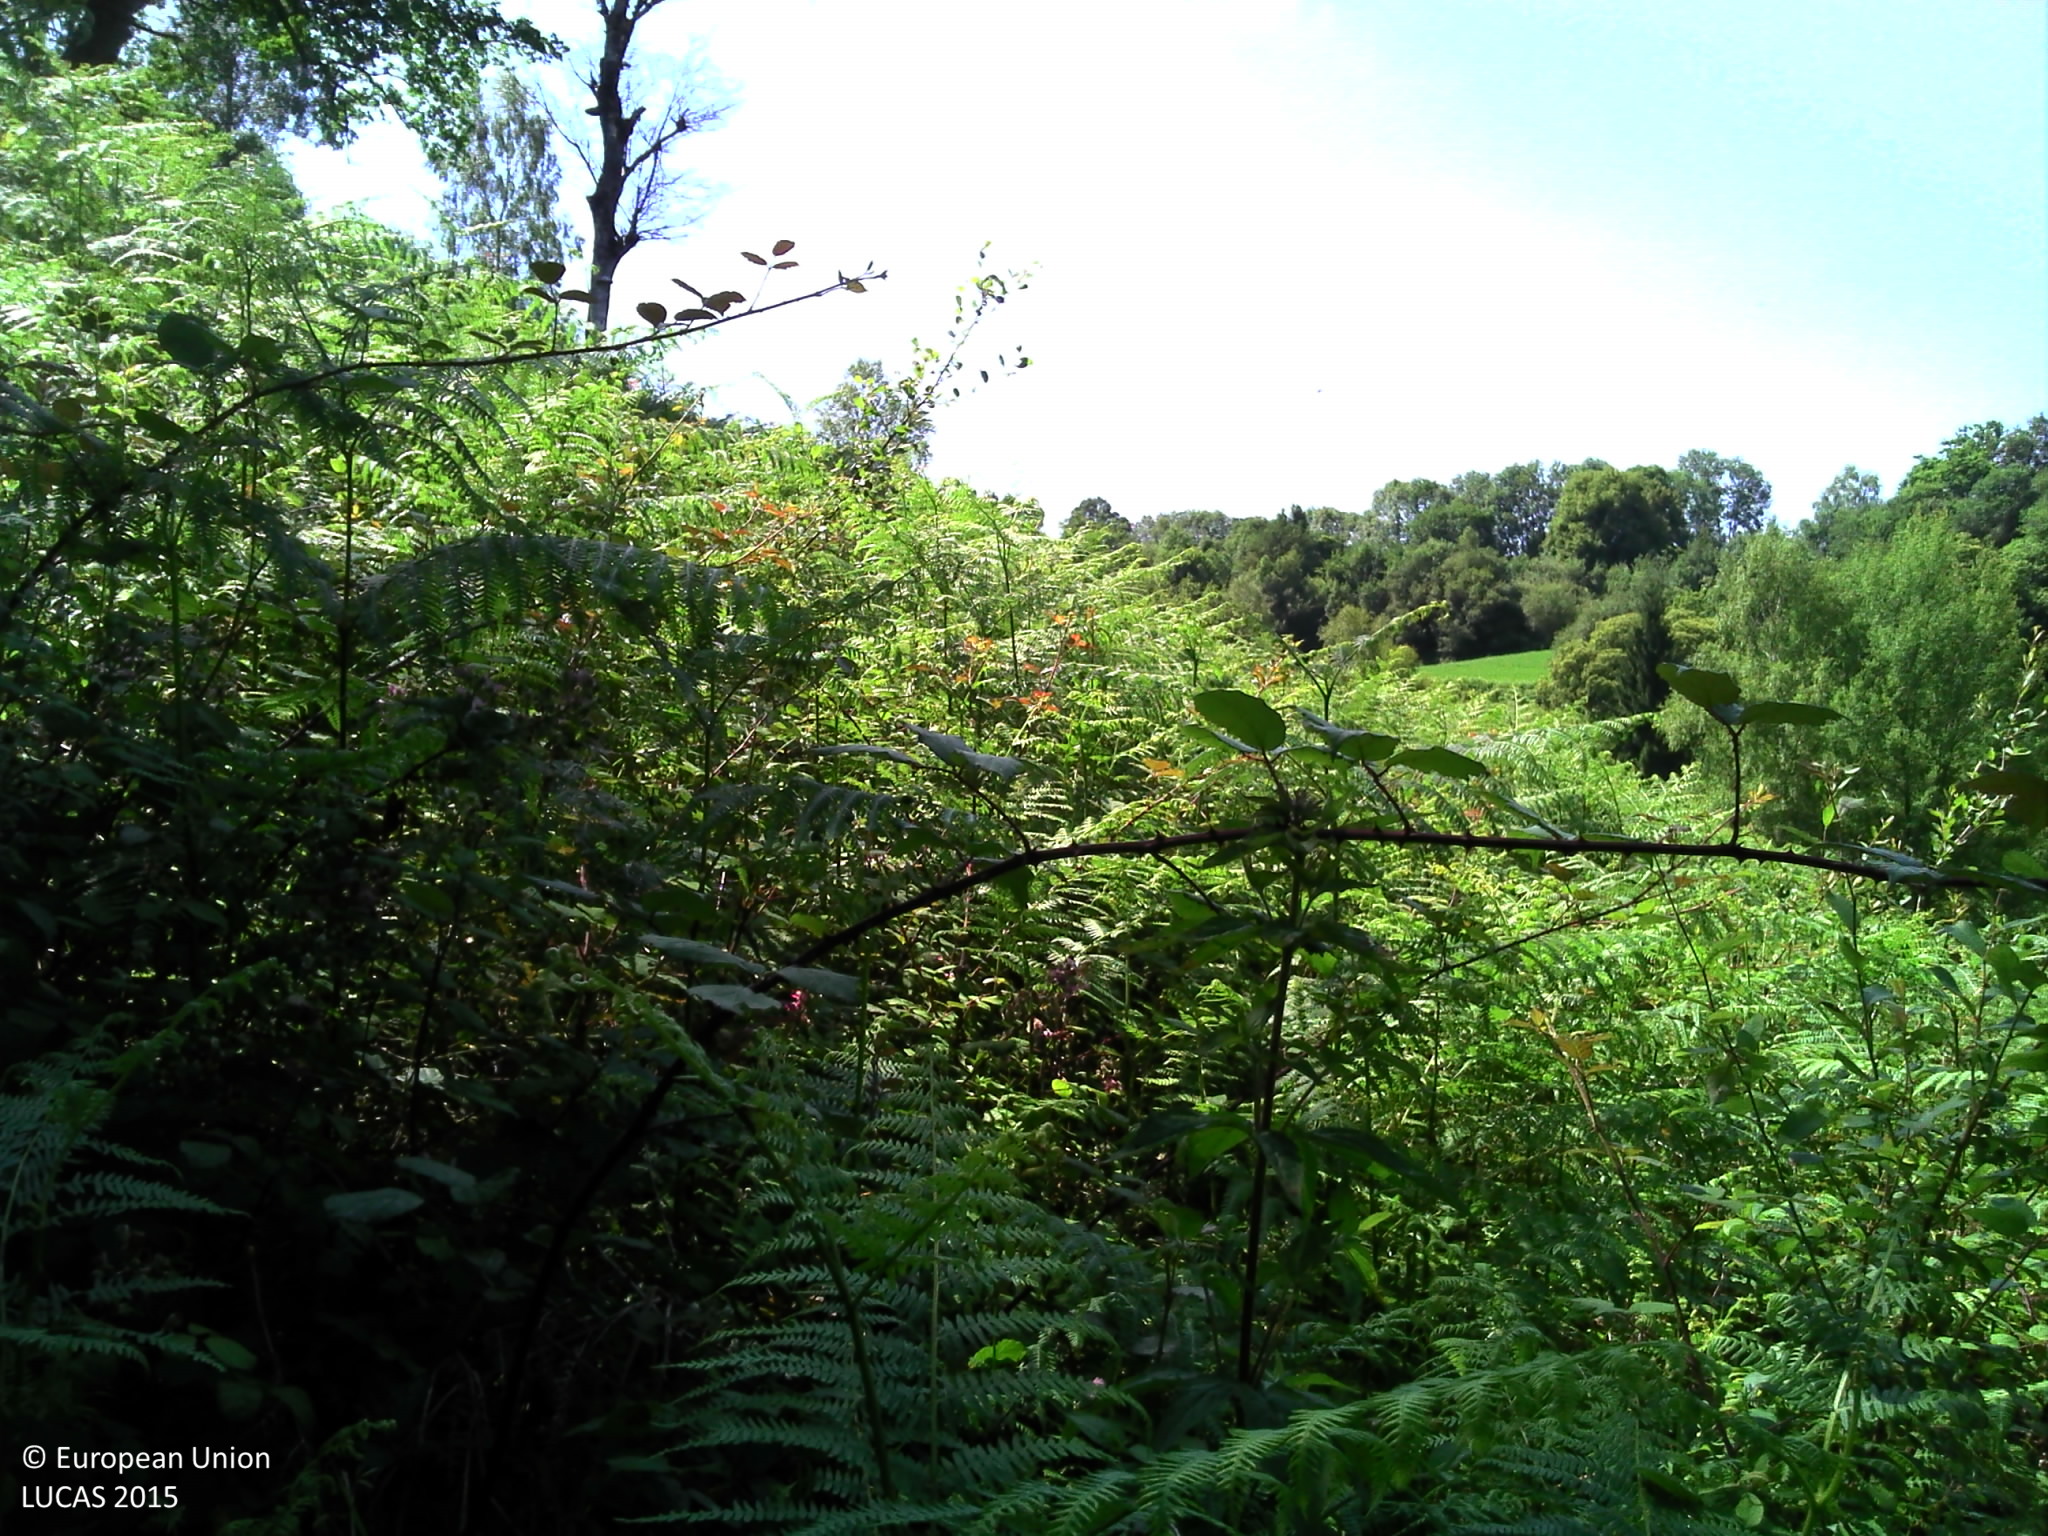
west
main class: Shrubland
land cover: Shrubland with sparse tree cover
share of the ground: > 75 %
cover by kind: herbaceous plants 85 %, shrubs 10 %, broadleaved forest trees 5 %
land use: Semi-natural and natural areas not in use
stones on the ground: < 10 %
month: June
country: FR
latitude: 43.1074
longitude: -0.1414
